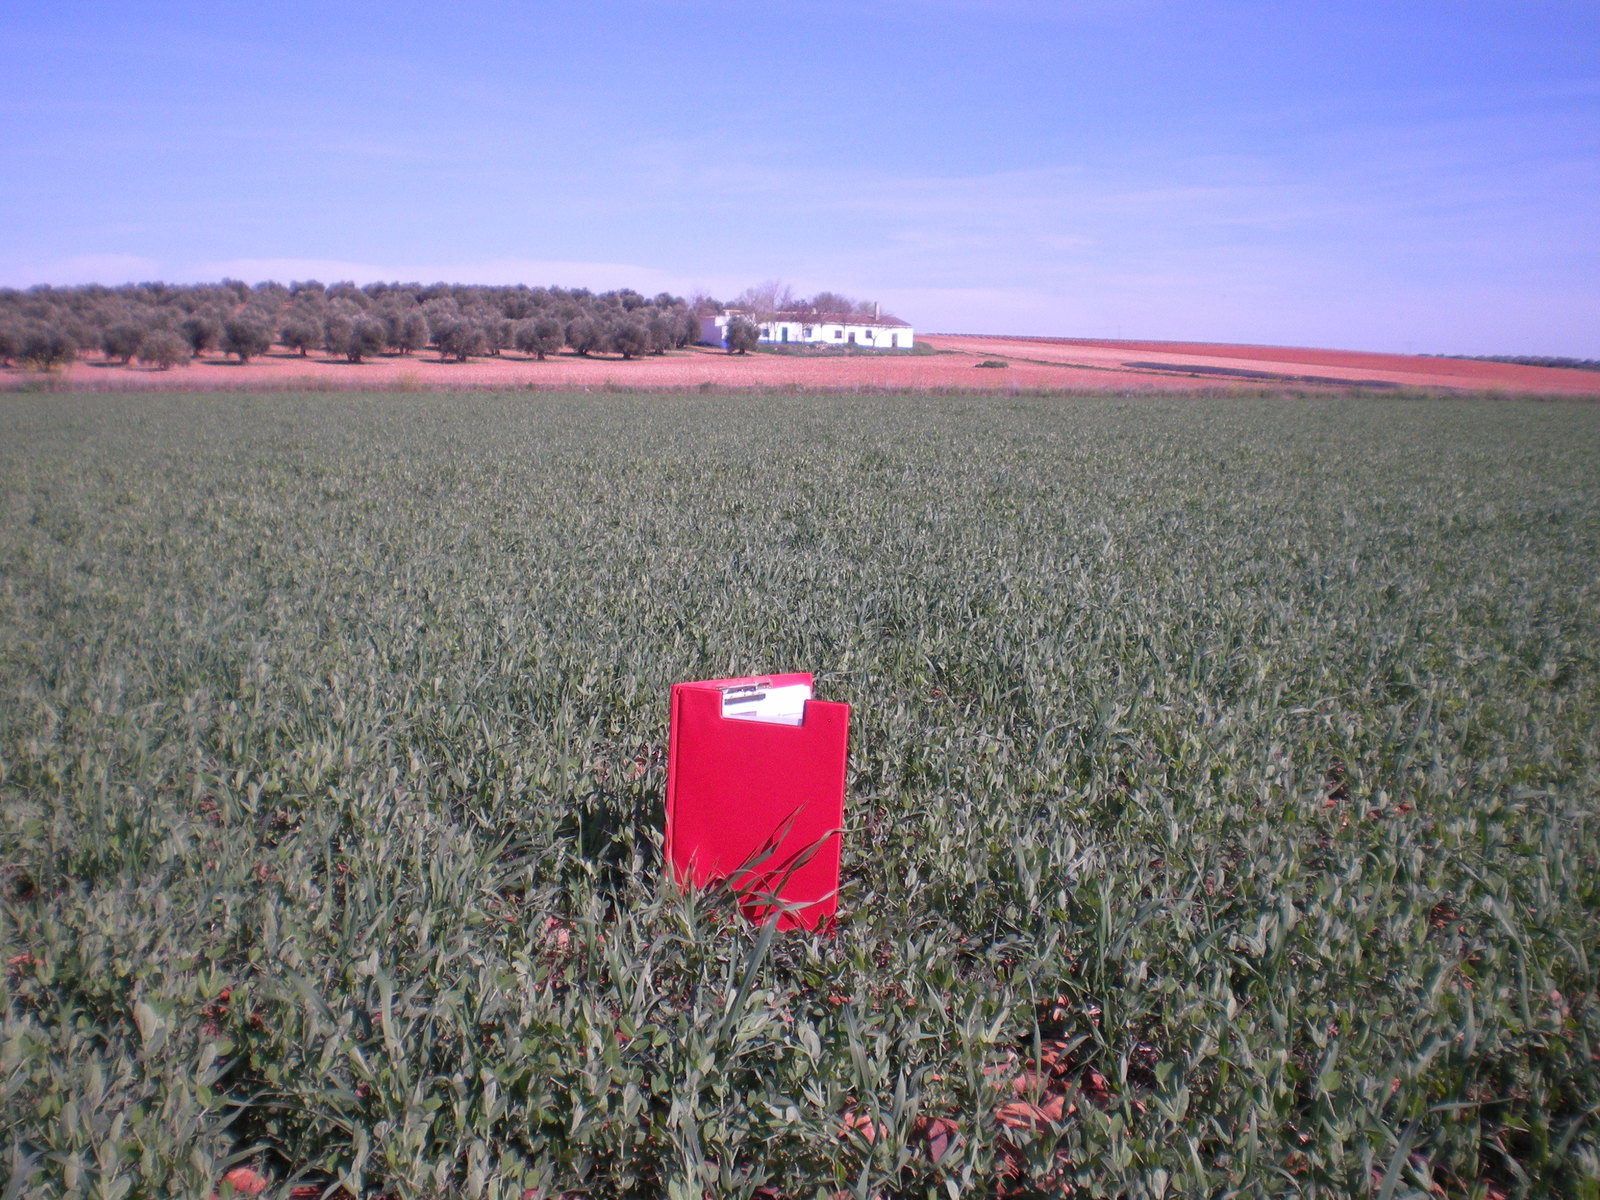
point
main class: Cropland
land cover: Dry pulses
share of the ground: > 75 %
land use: Agriculture (excluding fallow land and kitchen gardens)
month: March
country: ES
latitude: 39.0537
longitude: -3.2446
